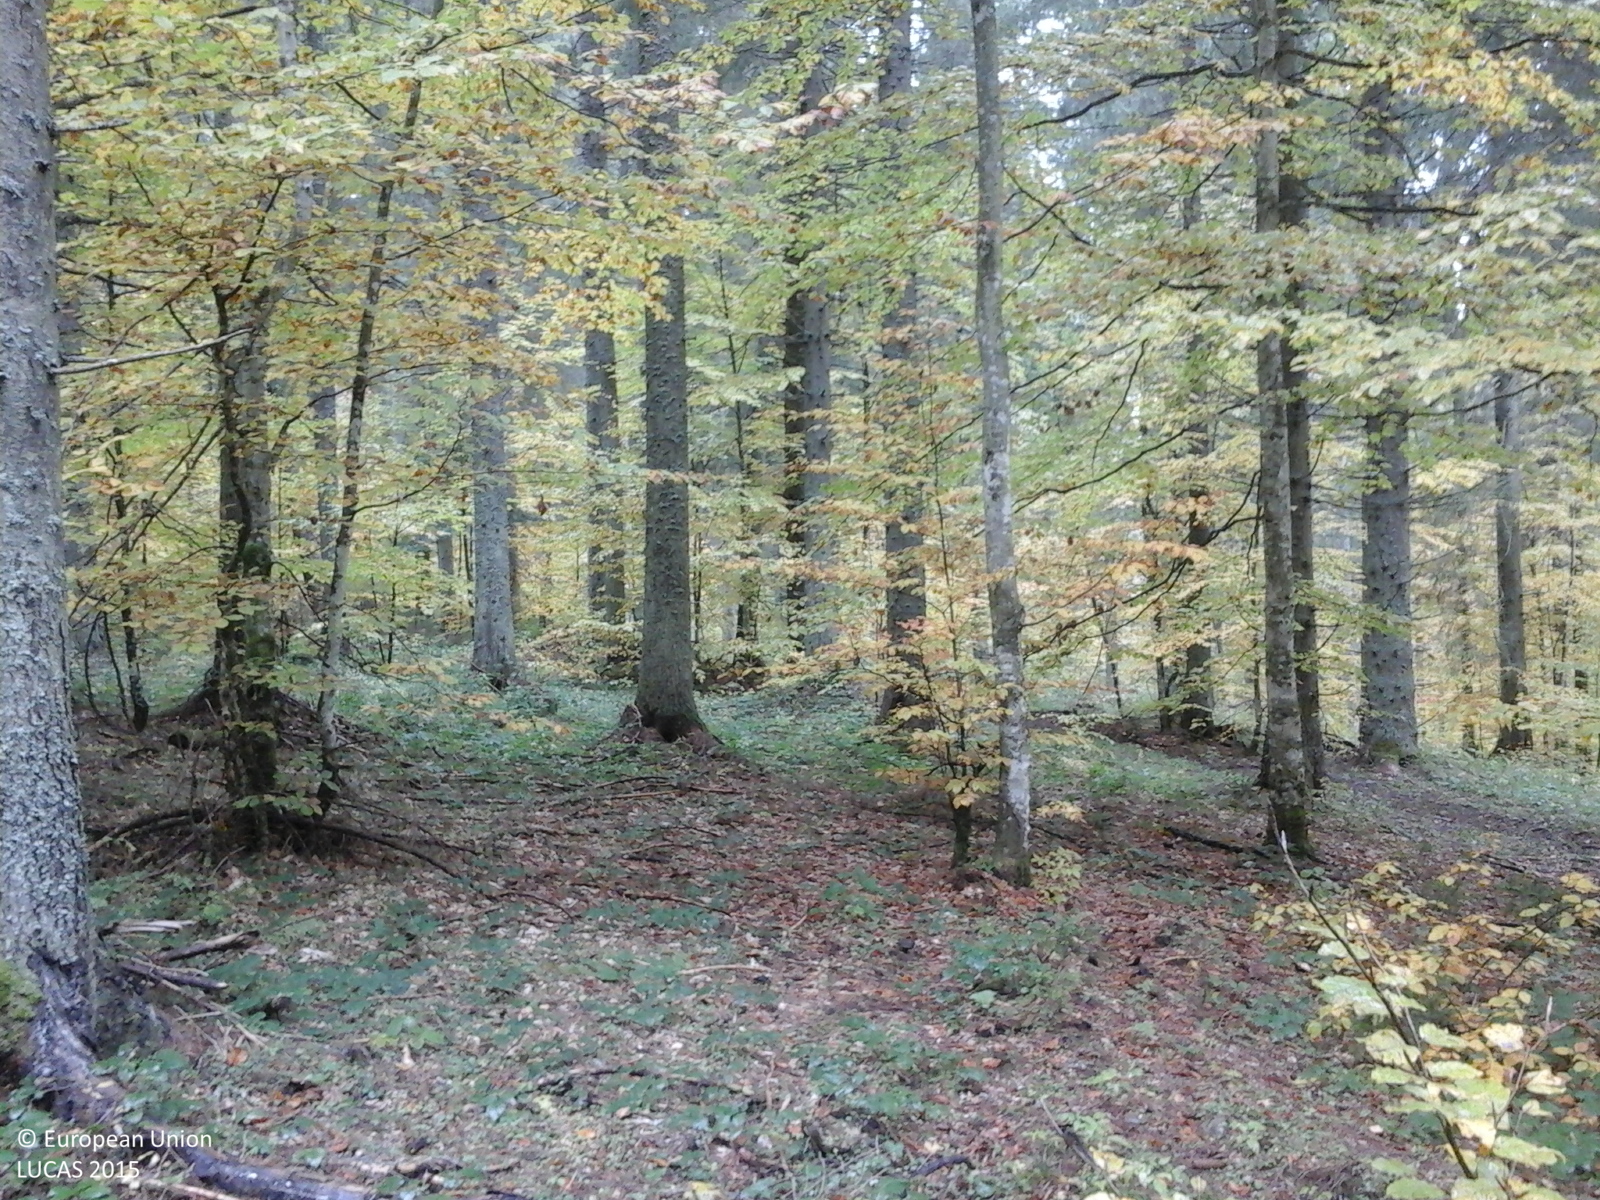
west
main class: Woodland
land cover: Other mixed woodland
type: alpine coniferous forest
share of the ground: > 75 %
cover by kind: coniferous forest trees 70 %, broadleaved forest trees 30 %
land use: Forestry
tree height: > 5 m
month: October
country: RO
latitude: 46.7690
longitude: 25.2559
